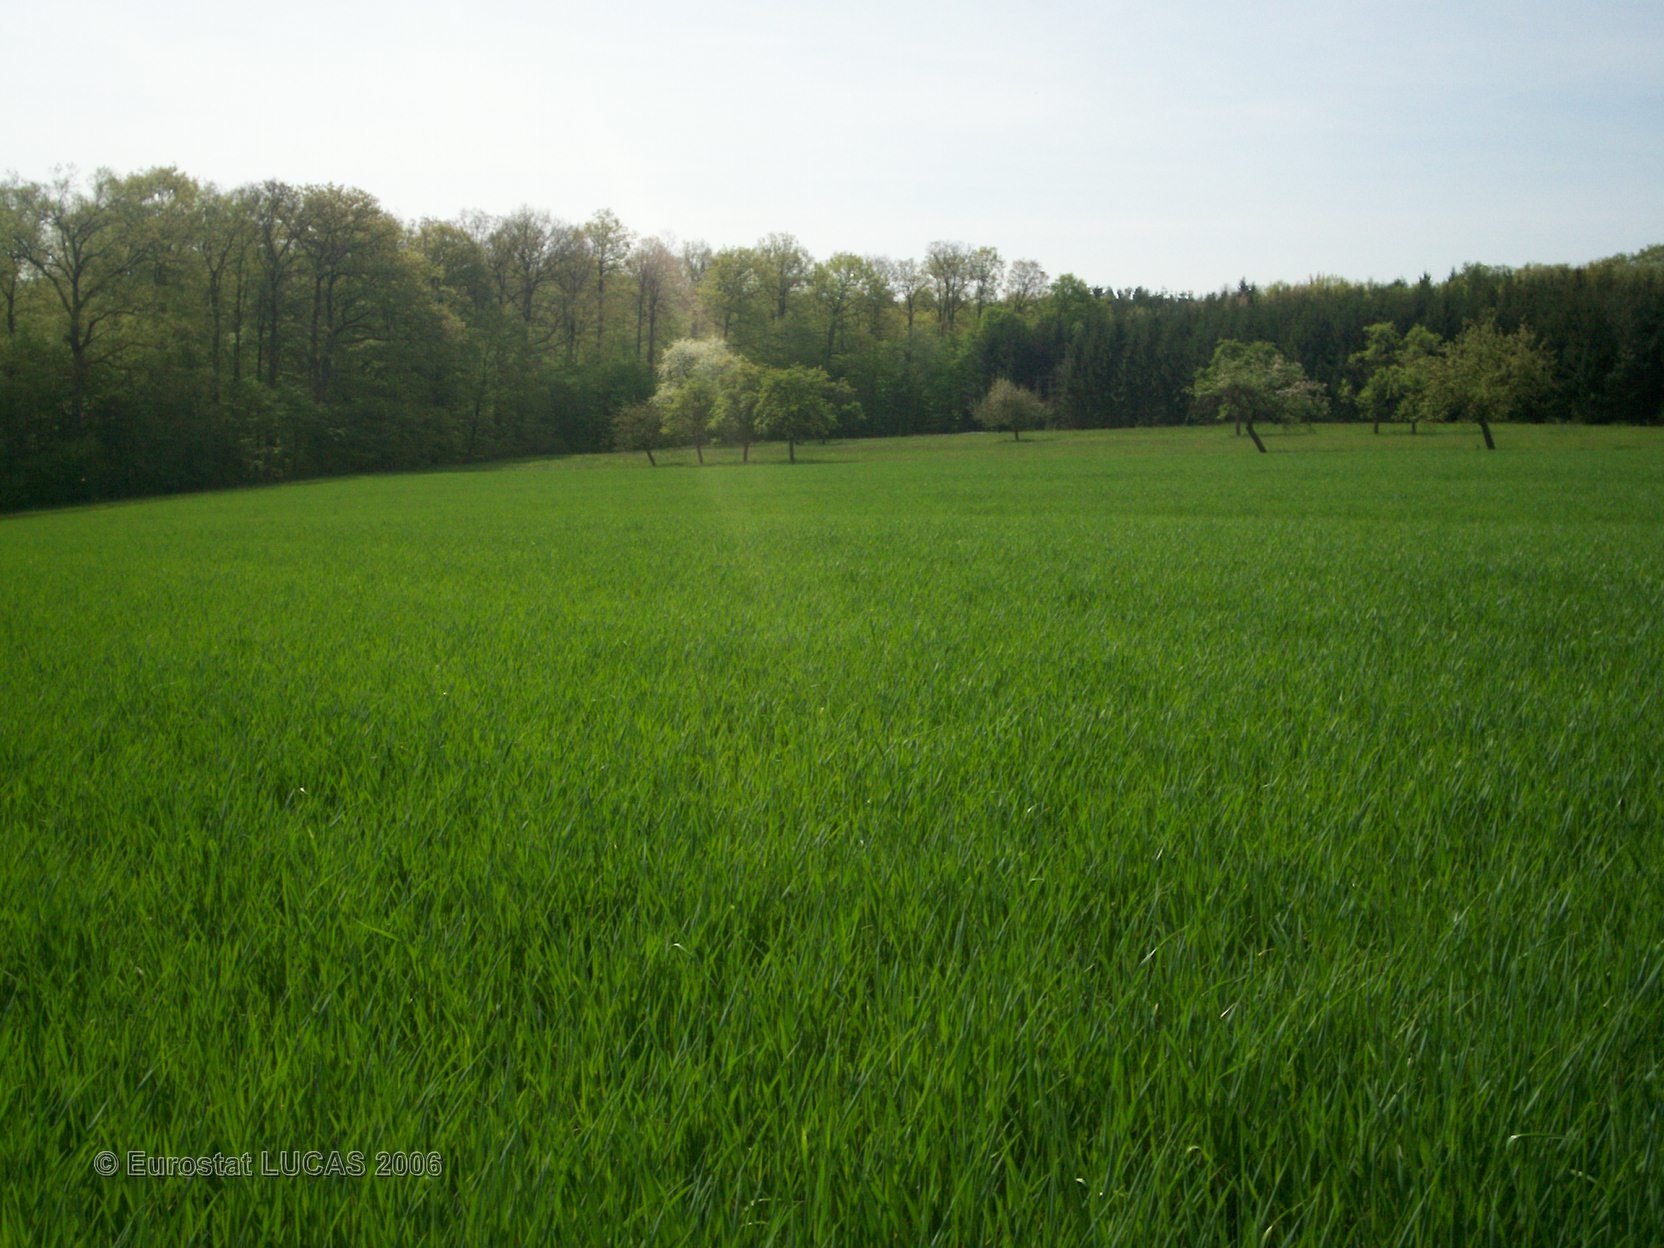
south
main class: Cropland
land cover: Barley
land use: Agriculture (excluding fallow land and kitchen gardens)
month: May
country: FR
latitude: 48.9205
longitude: 6.9845
